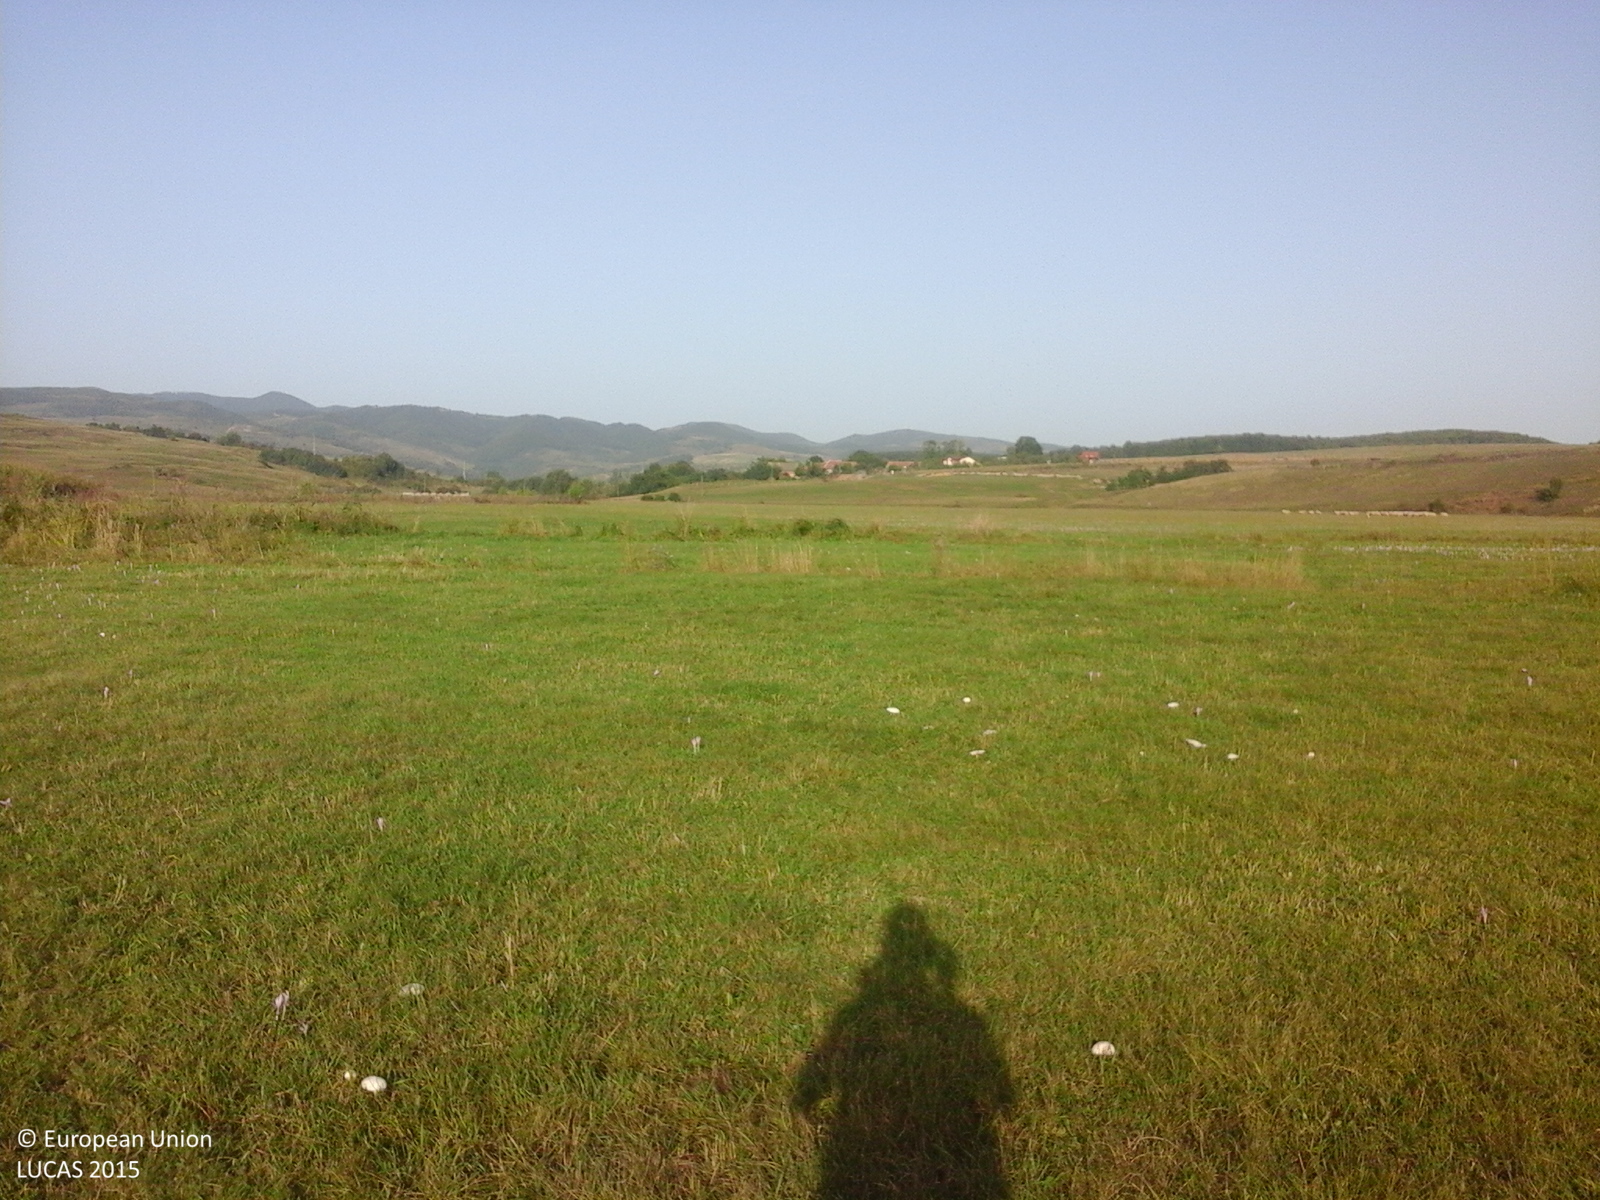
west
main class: Grassland
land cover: Grassland without tree/shrub cover
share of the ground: > 75 %
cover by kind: herbaceous plants 100 %
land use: Agriculture (excluding fallow land and kitchen gardens)
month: September
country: RO
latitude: 46.6422
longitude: 23.4854
